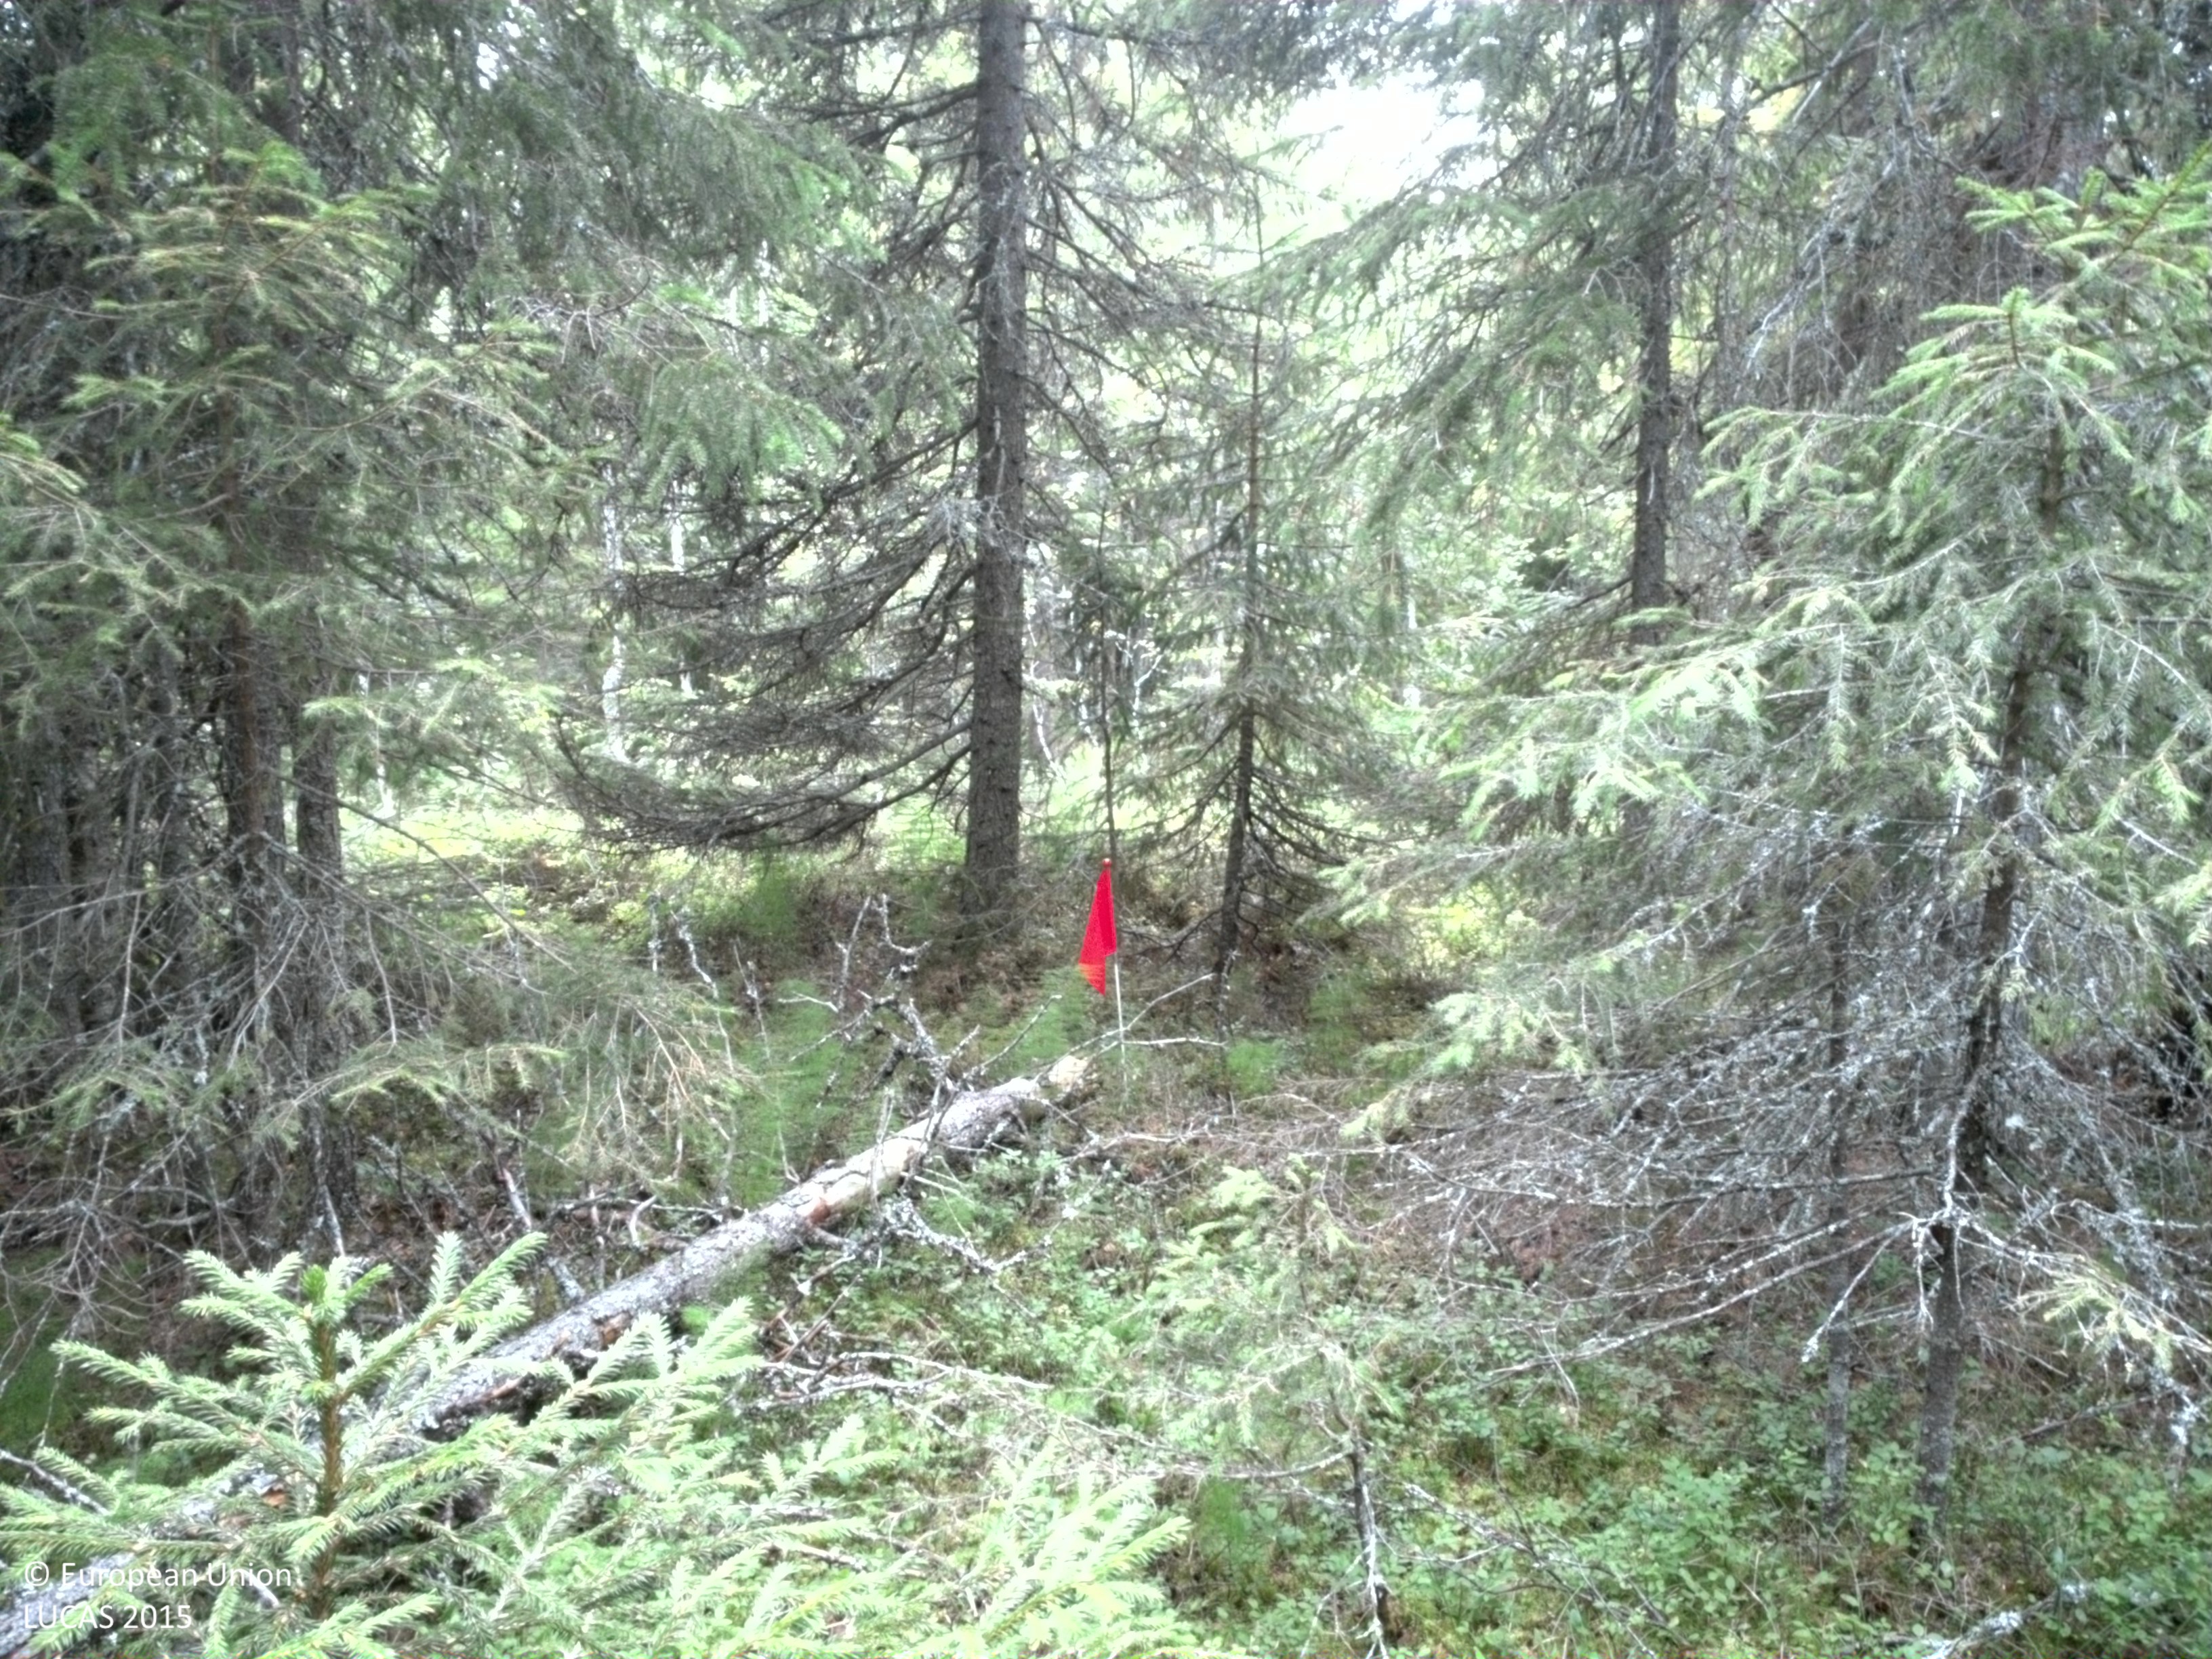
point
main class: Woodland
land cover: Spruce dominated coniferous woodland
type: boreal forest
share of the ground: > 75 %
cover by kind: coniferous forest trees 70 %, shrubs 25 %, broadleaved forest trees 5 %
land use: Forestry
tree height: > 5 m
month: August
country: SE
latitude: 64.5094
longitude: 20.1586
